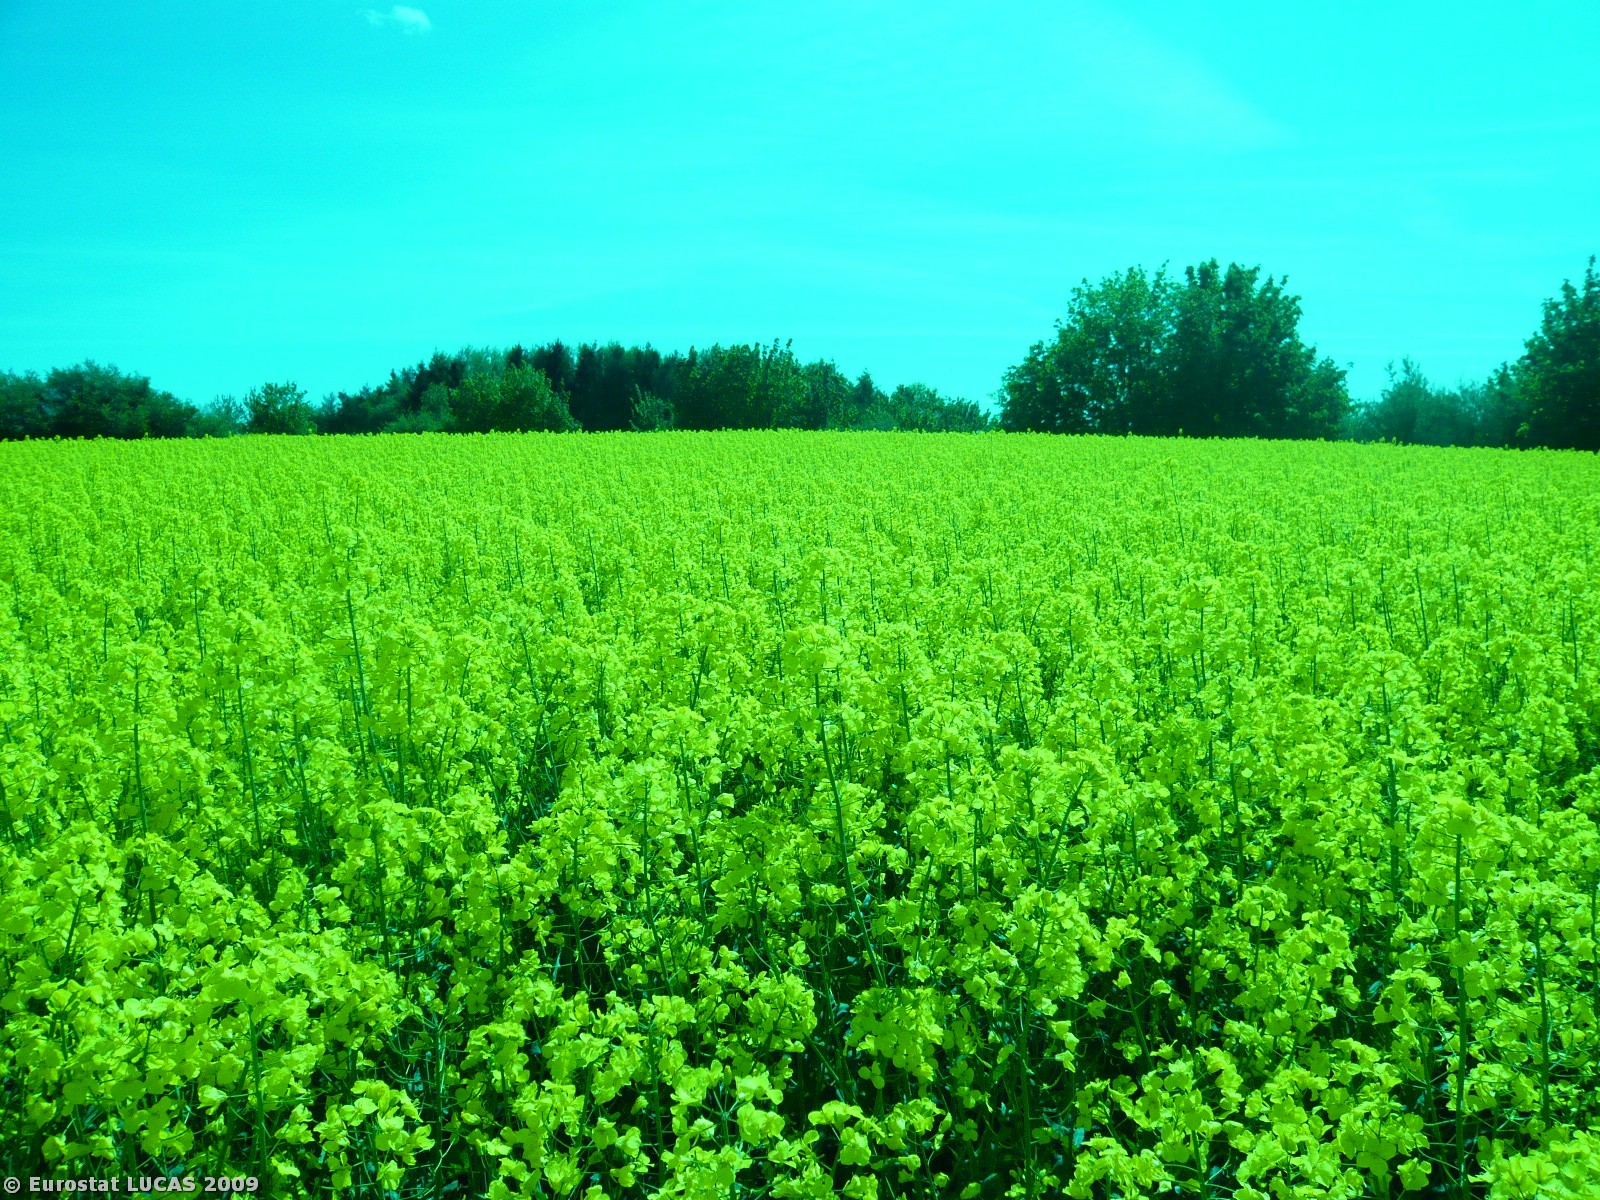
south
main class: Cropland
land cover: Rape and turnip rape
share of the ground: > 75 %
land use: Agriculture (excluding fallow land and kitchen gardens)
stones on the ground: < 10 %
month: May
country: DK
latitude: 55.0037
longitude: 11.9842
